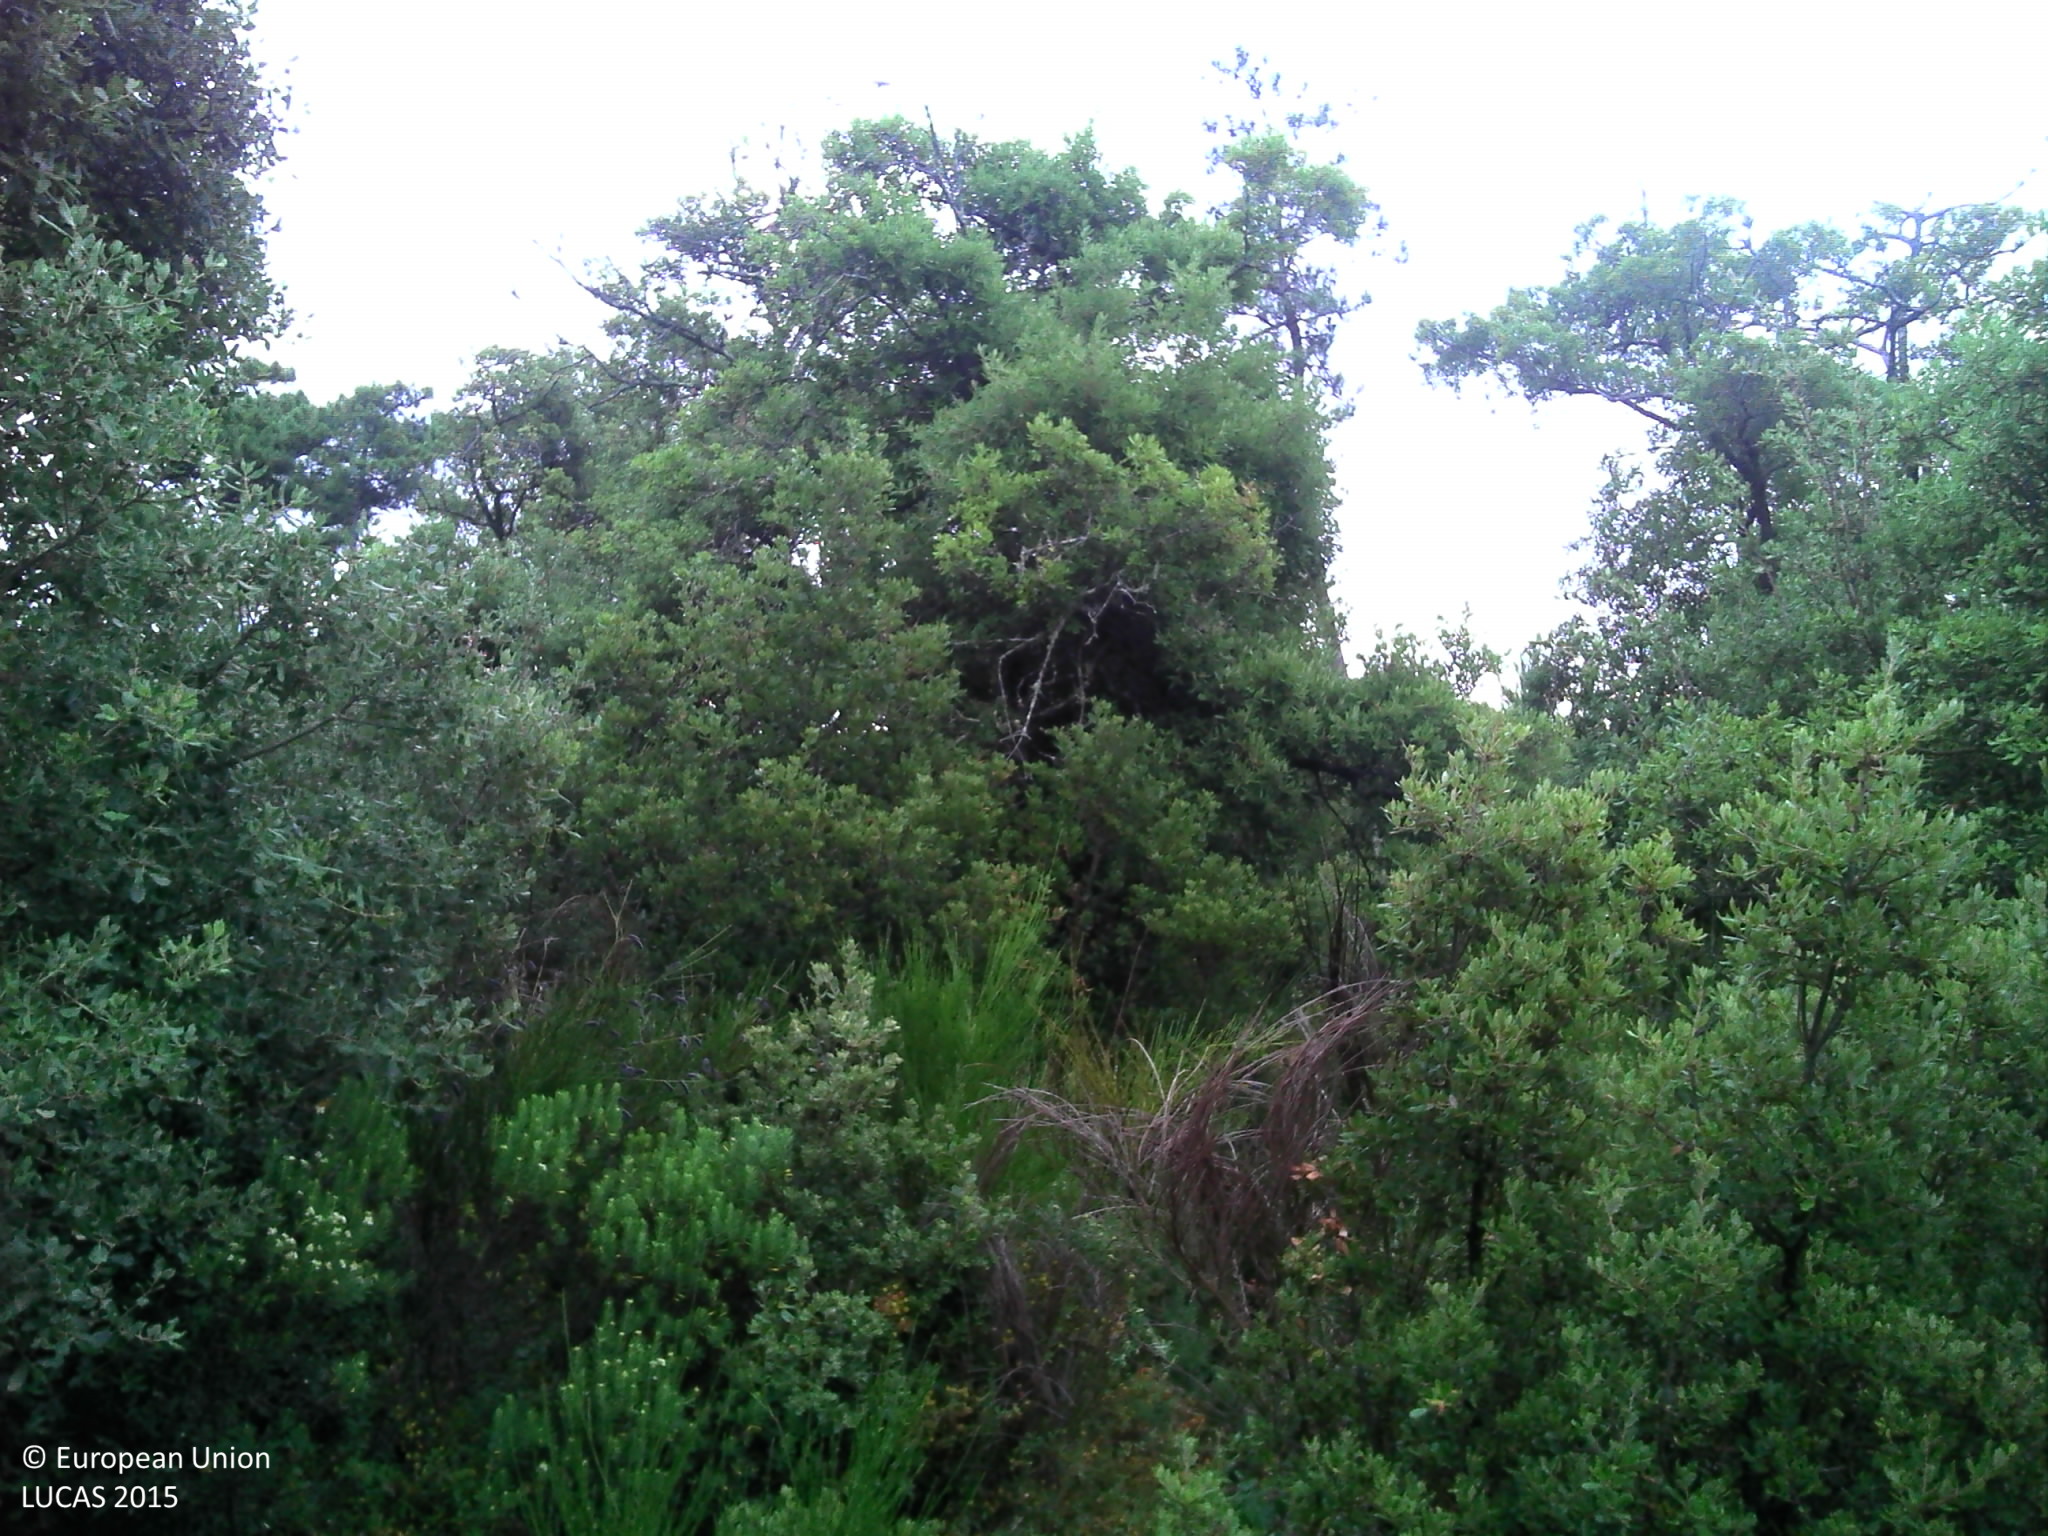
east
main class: Woodland
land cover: Pine dominated mixed woodland
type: coniferous forest of the mediterranean region
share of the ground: > 75 %
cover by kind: coniferous forest trees 75 %, broadleaved forest trees 25 %
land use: Forestry
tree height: > 5 m
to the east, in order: Pine dominated mixed woodland; Tracks; Pine dominated mixed woodland; Tracks; Pine dominated mixed woodland; Grassland without tree/shrub cover; Paved roads, cycling and walking lanes; Grassland without tree/shrub cover; Pine dominated mixed woodland
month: June
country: FR
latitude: 45.6593
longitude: -1.1303
